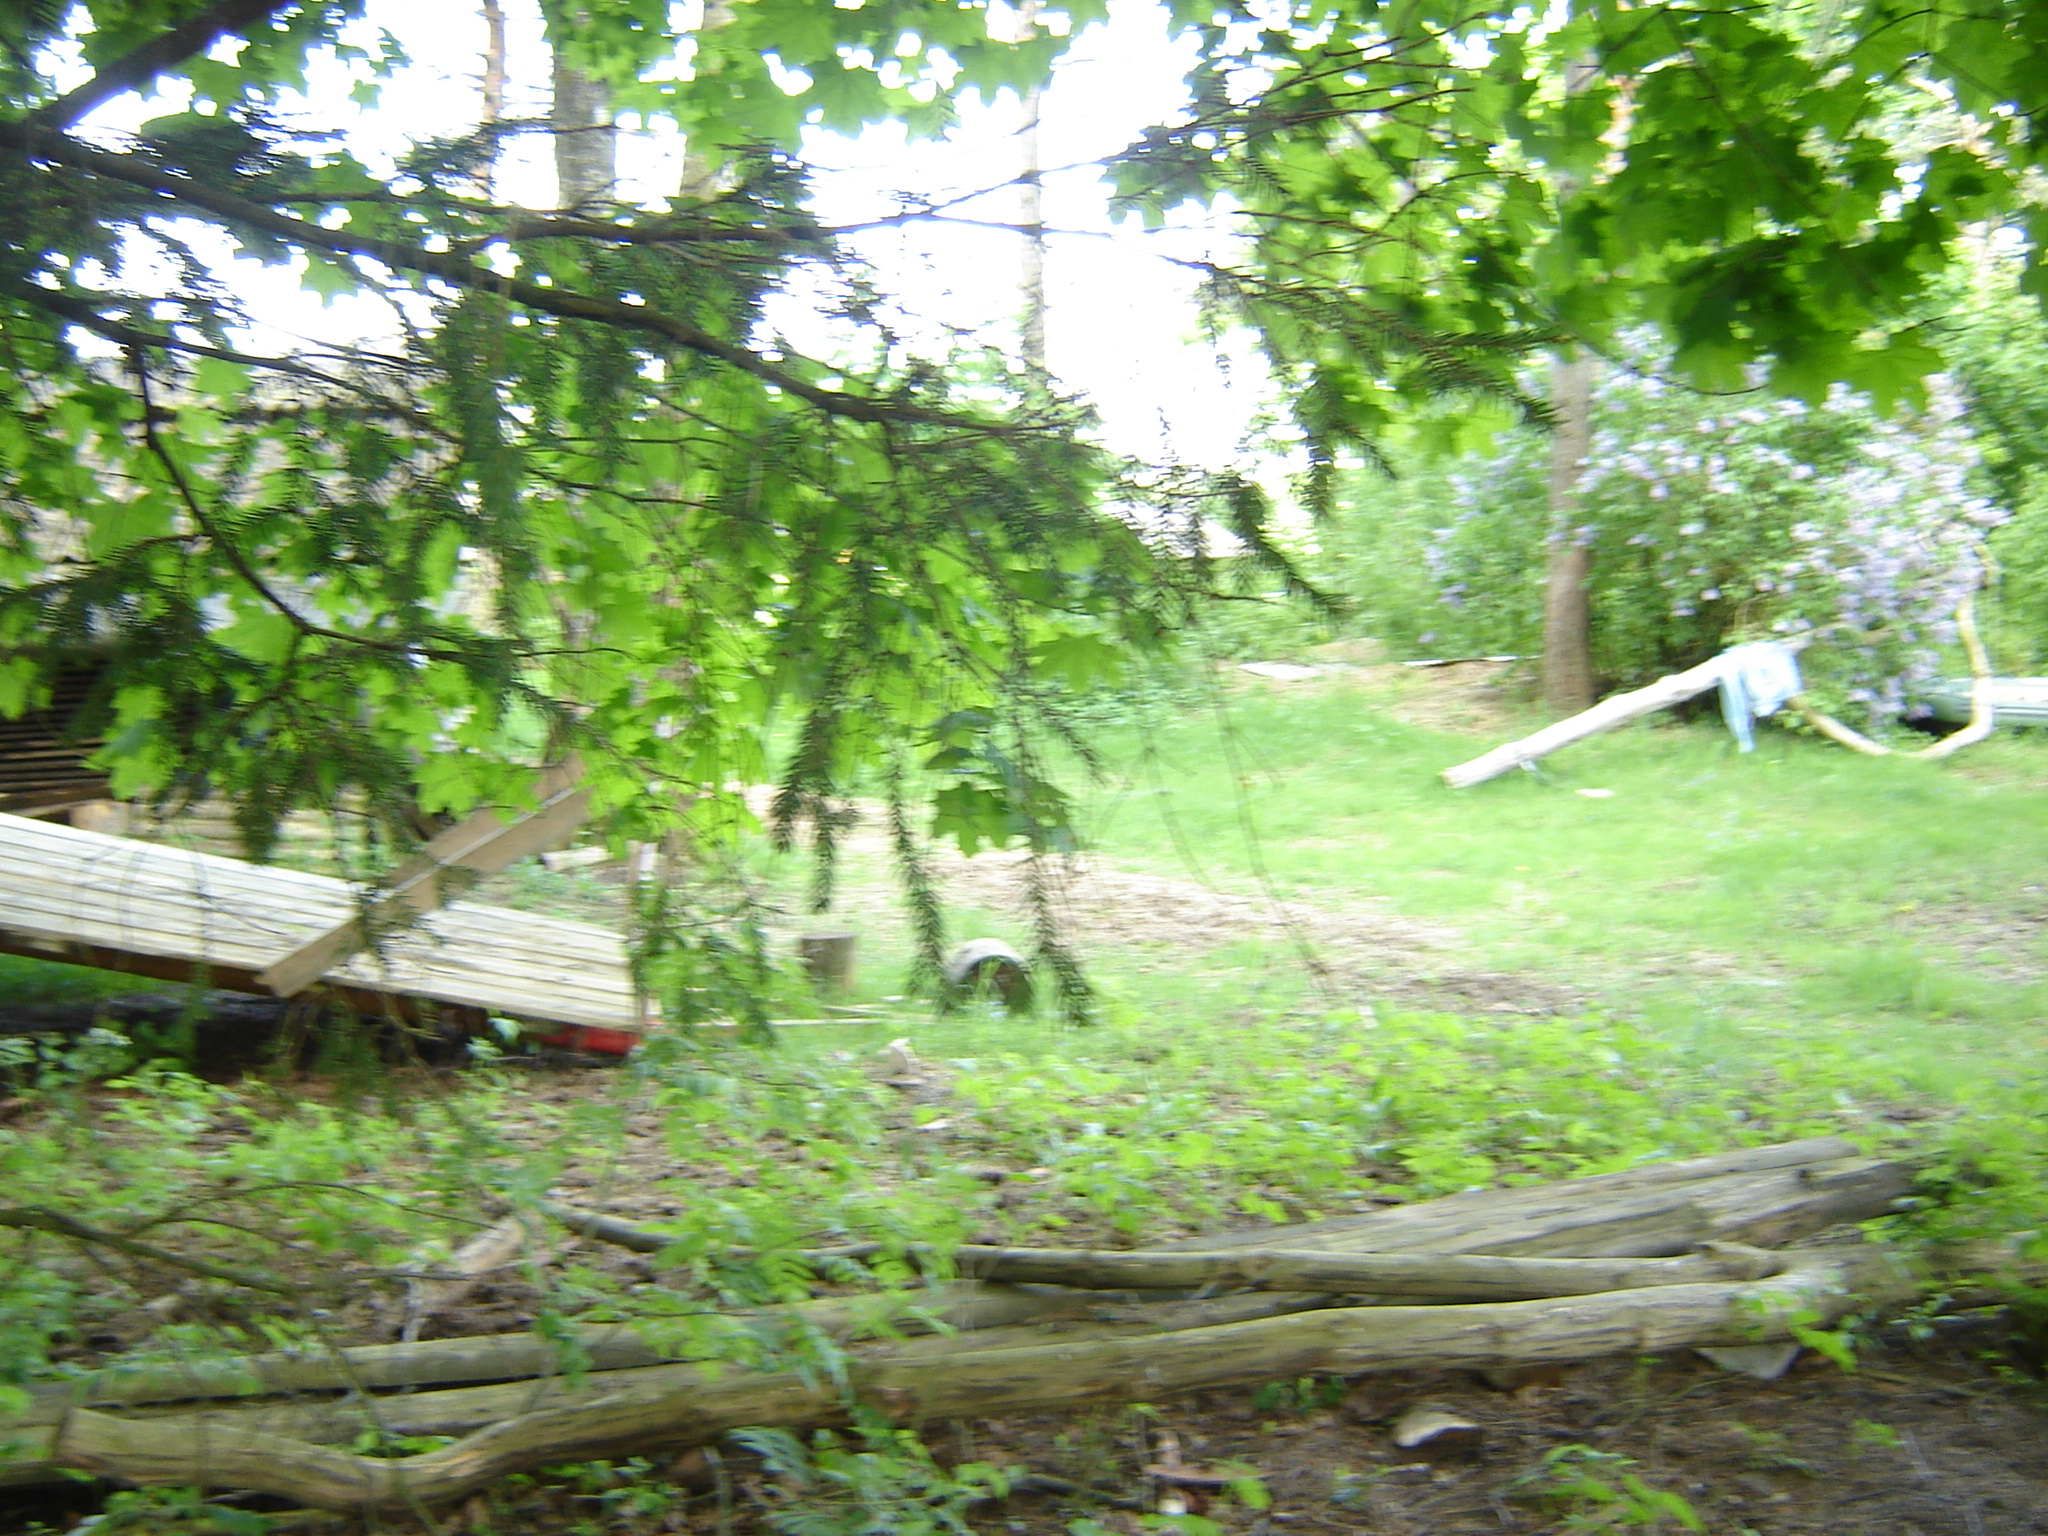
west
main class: Woodland
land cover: Other mixed woodland
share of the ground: > 75 %
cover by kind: coniferous forest trees 55 %, broadleaved forest trees 30 %, unconsolidated bare surface 10 %, herbaceous plants 5 %
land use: Forestry
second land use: Residential
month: May
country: LT
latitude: 55.7181
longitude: 25.3215
